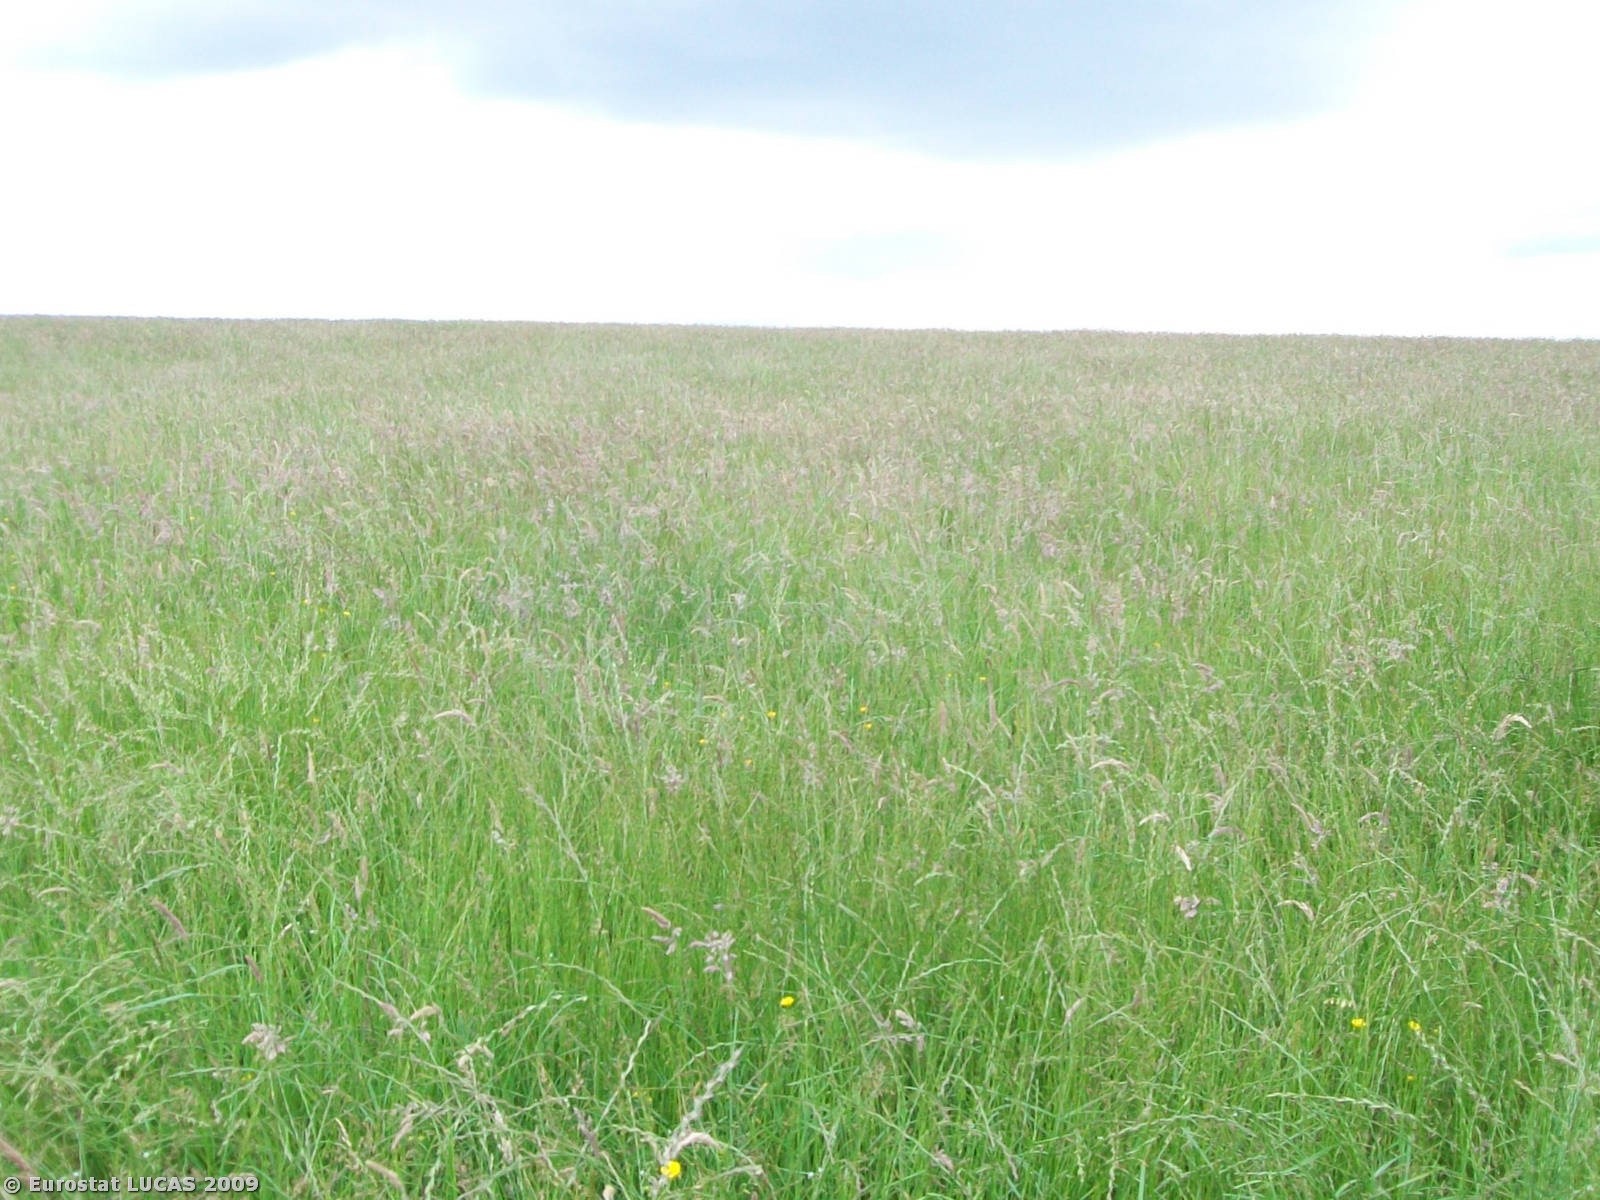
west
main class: Grassland
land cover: Grassland without tree/shrub cover
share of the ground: > 75 %
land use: Agriculture (excluding fallow land and kitchen gardens)
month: July
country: GB
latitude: 54.4715
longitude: -1.8581
